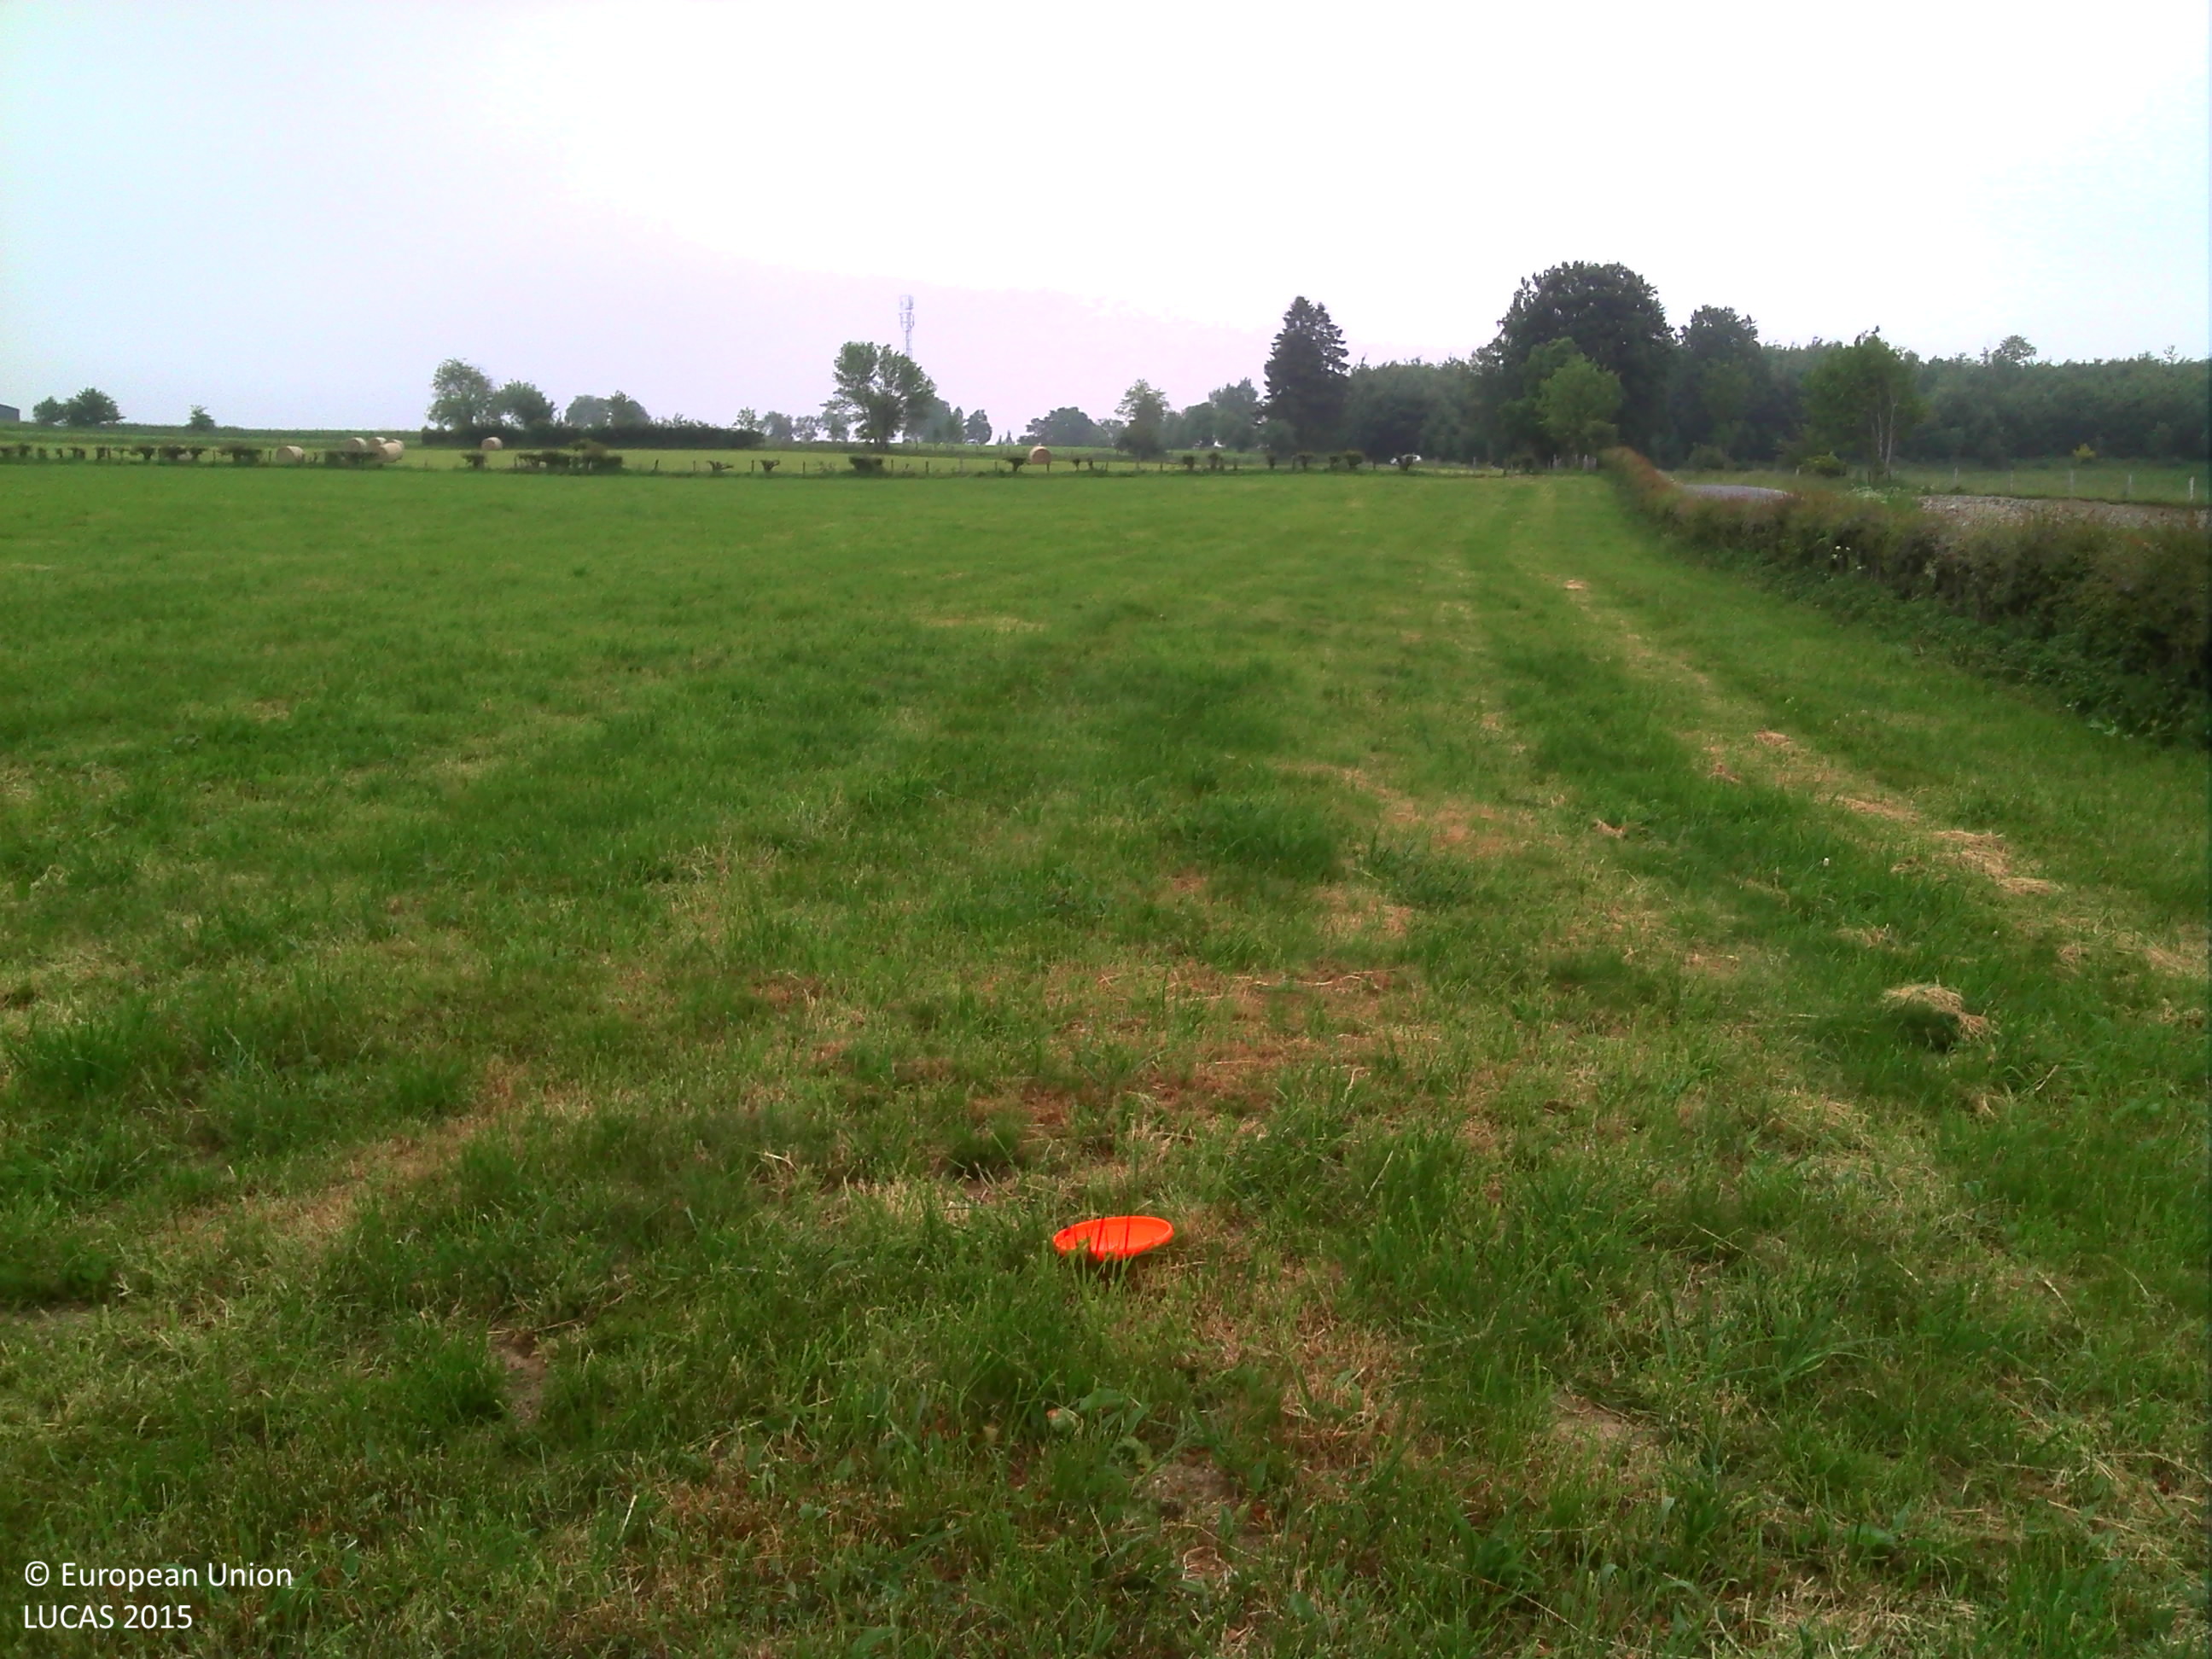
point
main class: Grassland
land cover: Grassland without tree/shrub cover
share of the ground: > 75 %
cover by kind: herbaceous plants 100 %
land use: Agriculture (excluding fallow land and kitchen gardens)
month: June
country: BE
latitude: 50.4113
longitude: 6.2703
